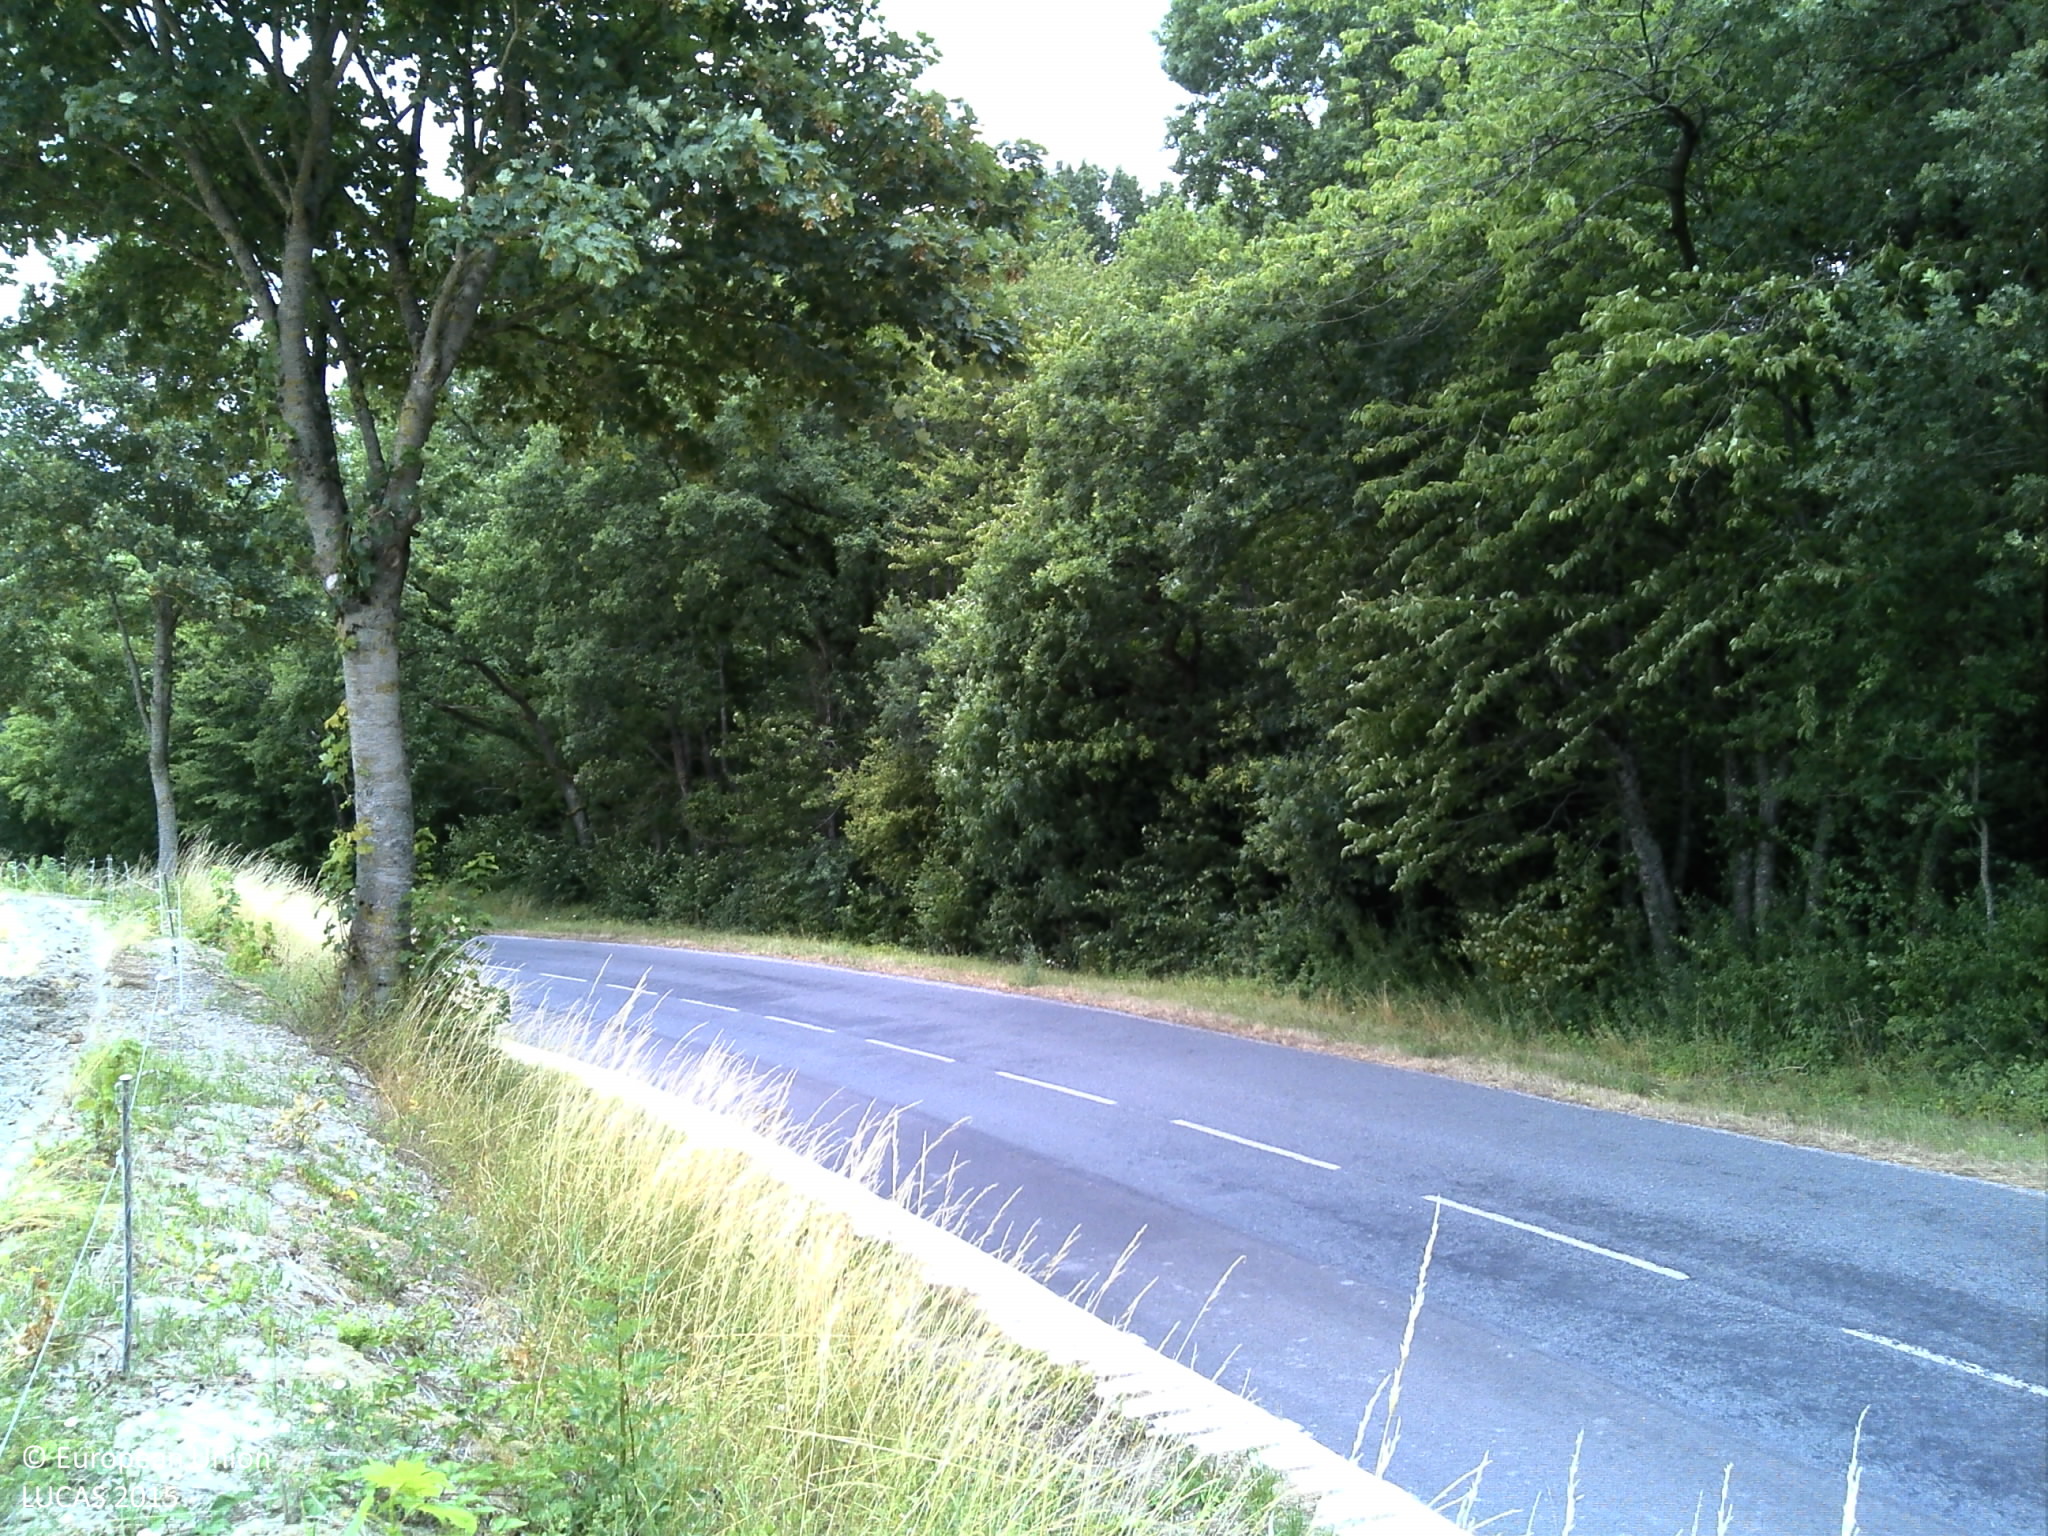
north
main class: Cropland
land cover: Barley
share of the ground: > 75 %
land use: Agriculture (excluding fallow land and kitchen gardens)
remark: Harvested field
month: July
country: FR
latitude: 49.1504
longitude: 4.8836
